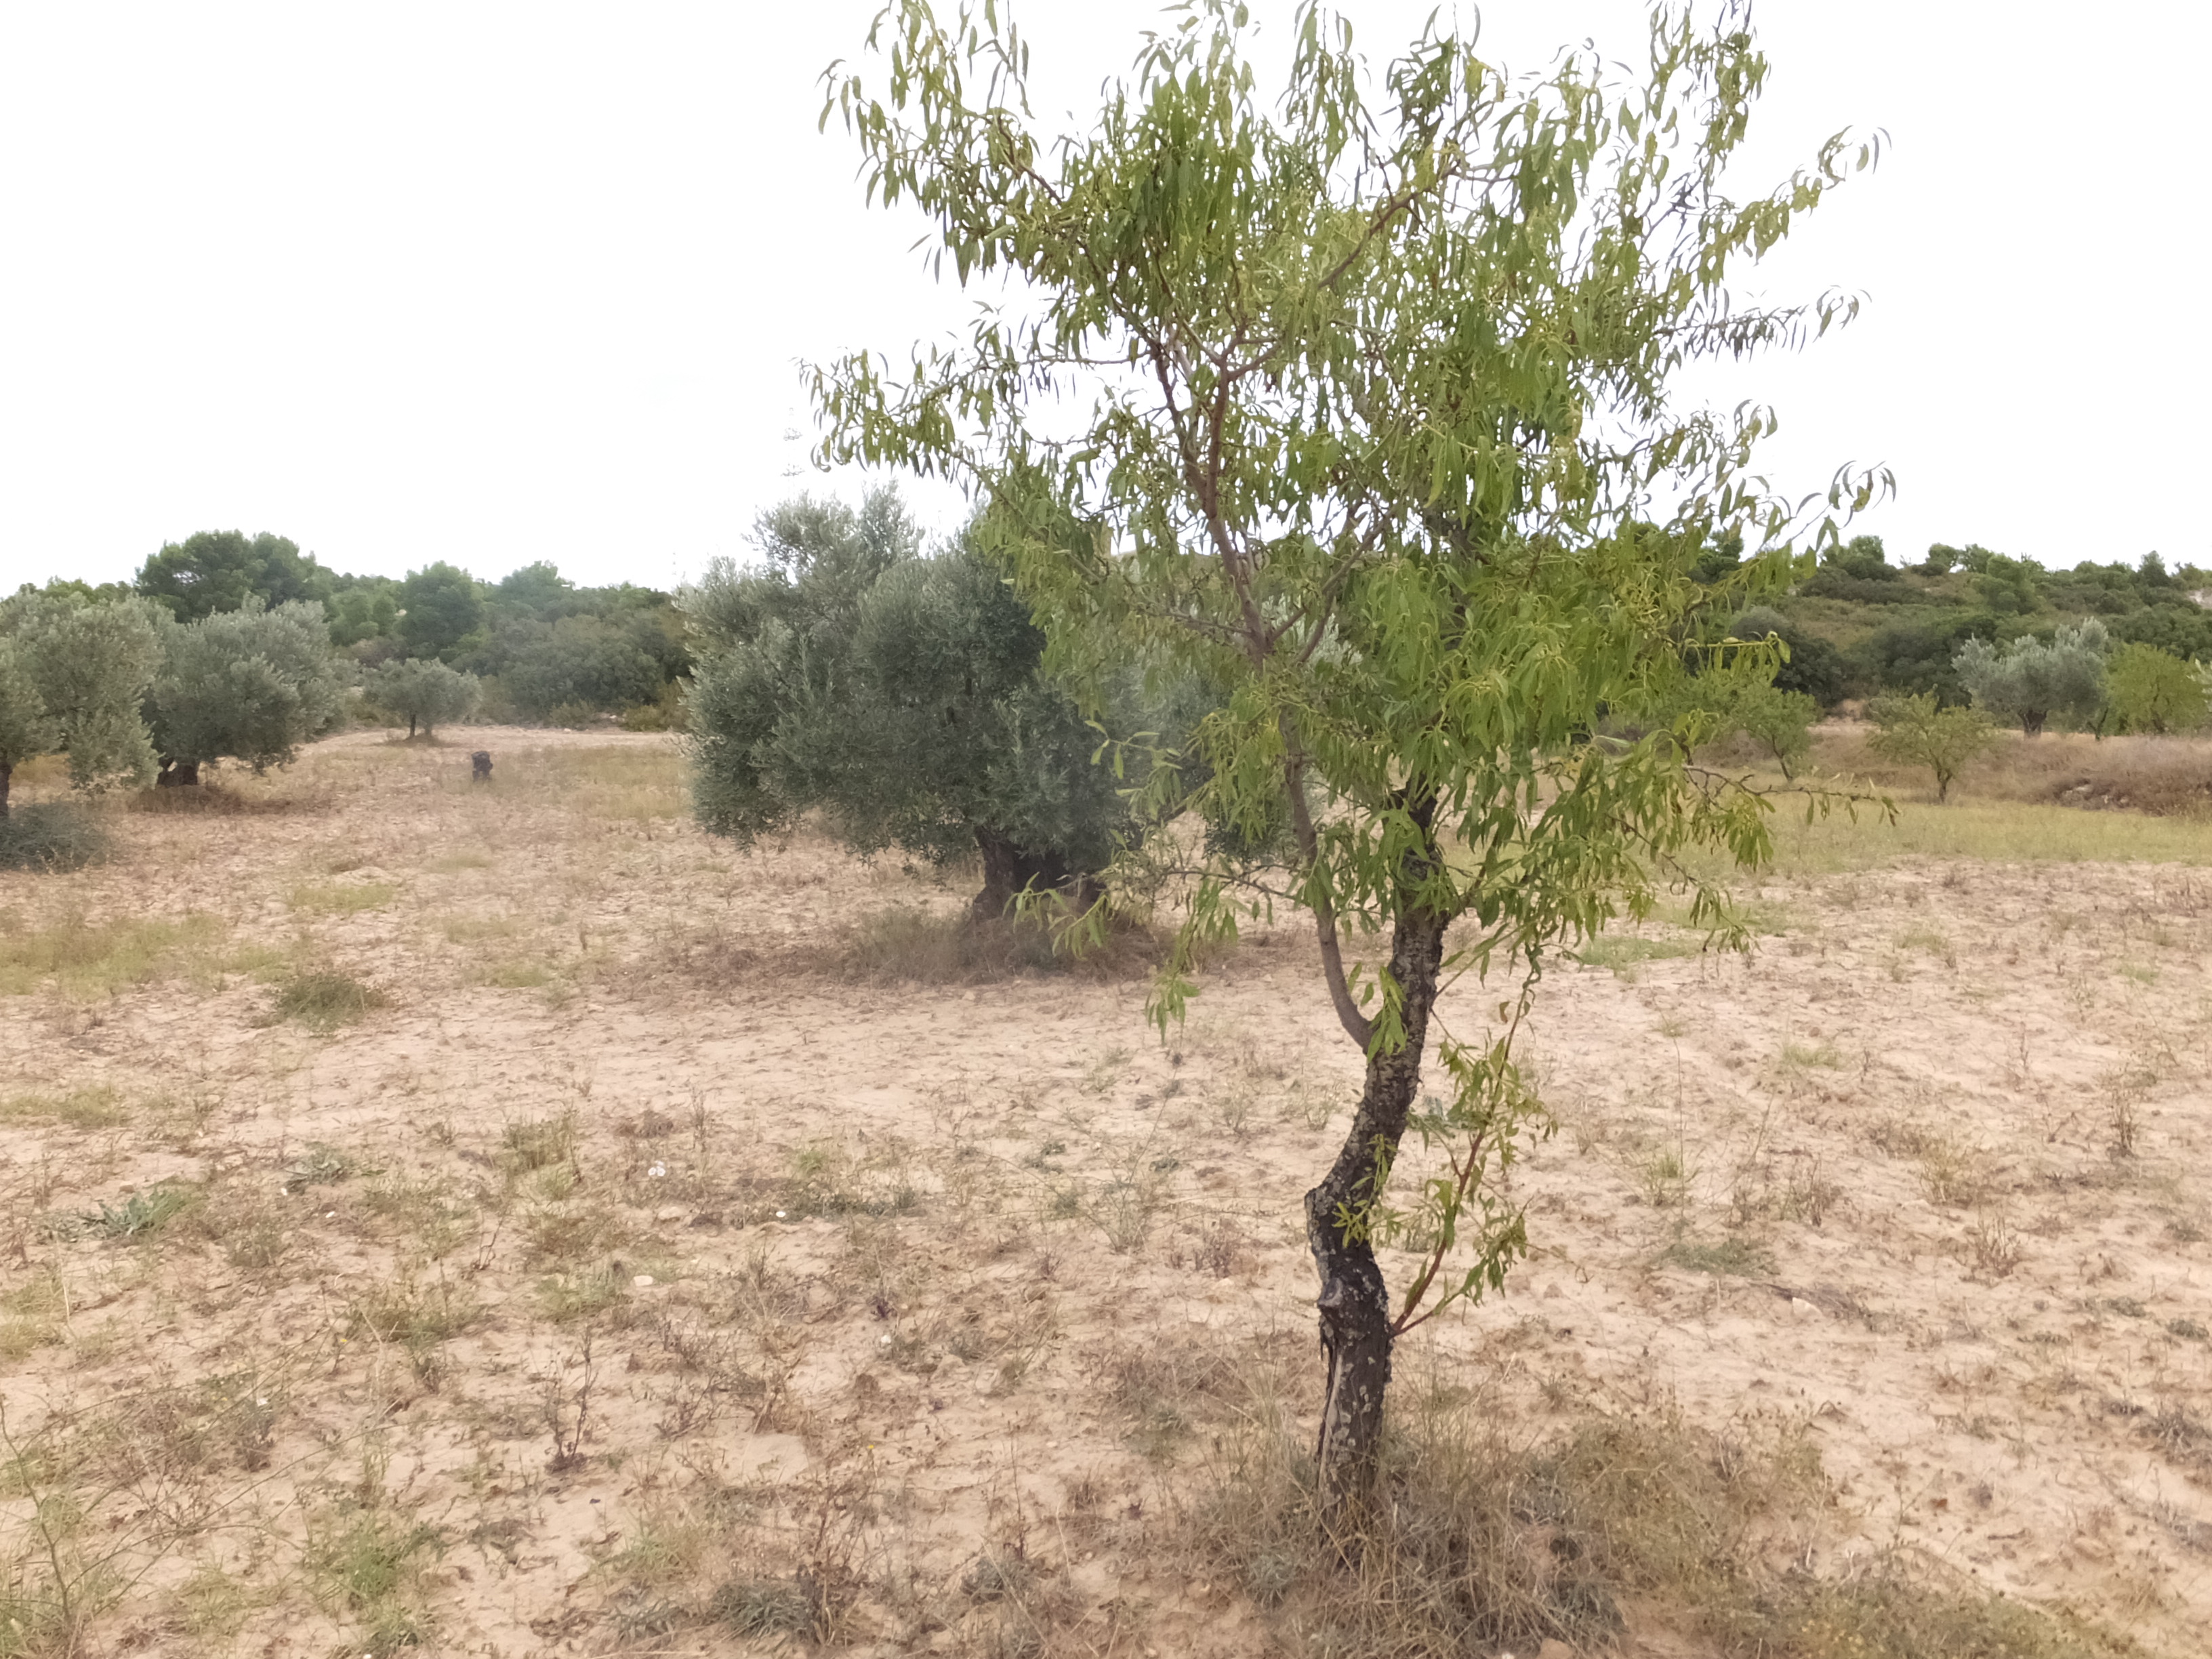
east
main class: Cropland
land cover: Nuts trees
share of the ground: > 75 %
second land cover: Other bare soil
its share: > 75 %
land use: Agriculture (excluding fallow land and kitchen gardens)
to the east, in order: Nuts trees; Other bare soil; Olive groves; Shrubland without tree cover; Tracks; Shrubland without tree cover; Tracks; Shruby margins; Nuts trees; Shruby margins; Nuts trees
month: August
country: ES
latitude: 41.3326
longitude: 0.2980
